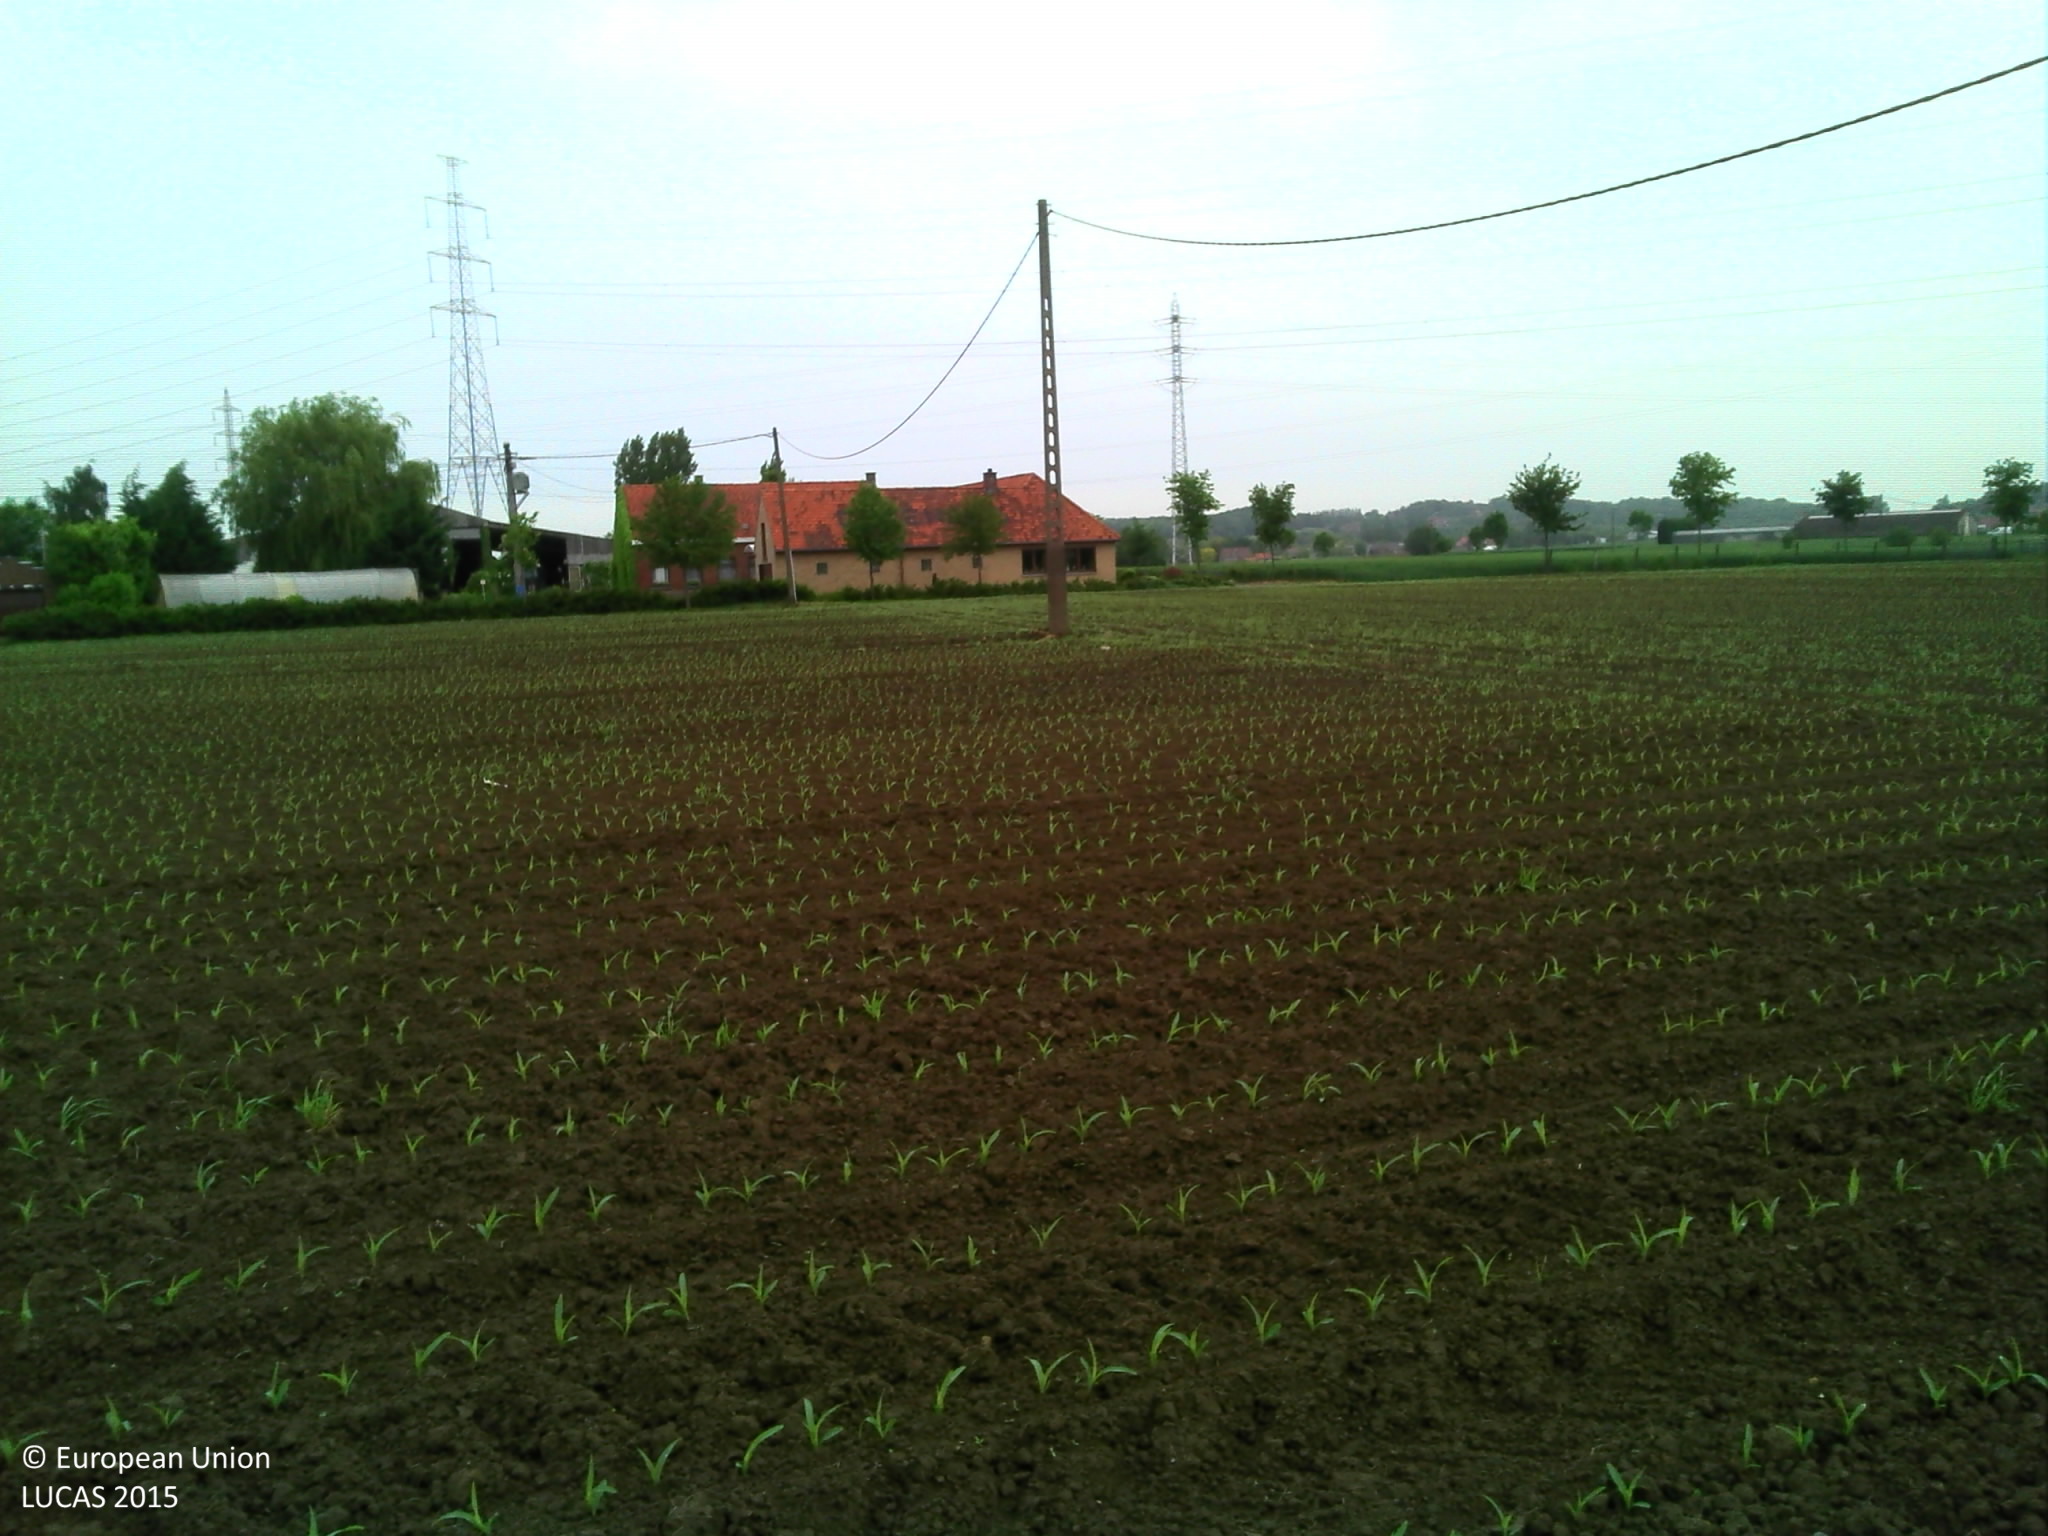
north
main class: Cropland
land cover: Maize
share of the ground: < 10 %
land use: Agriculture (excluding fallow land and kitchen gardens)
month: June
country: BE
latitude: 50.7898
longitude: 3.4525
